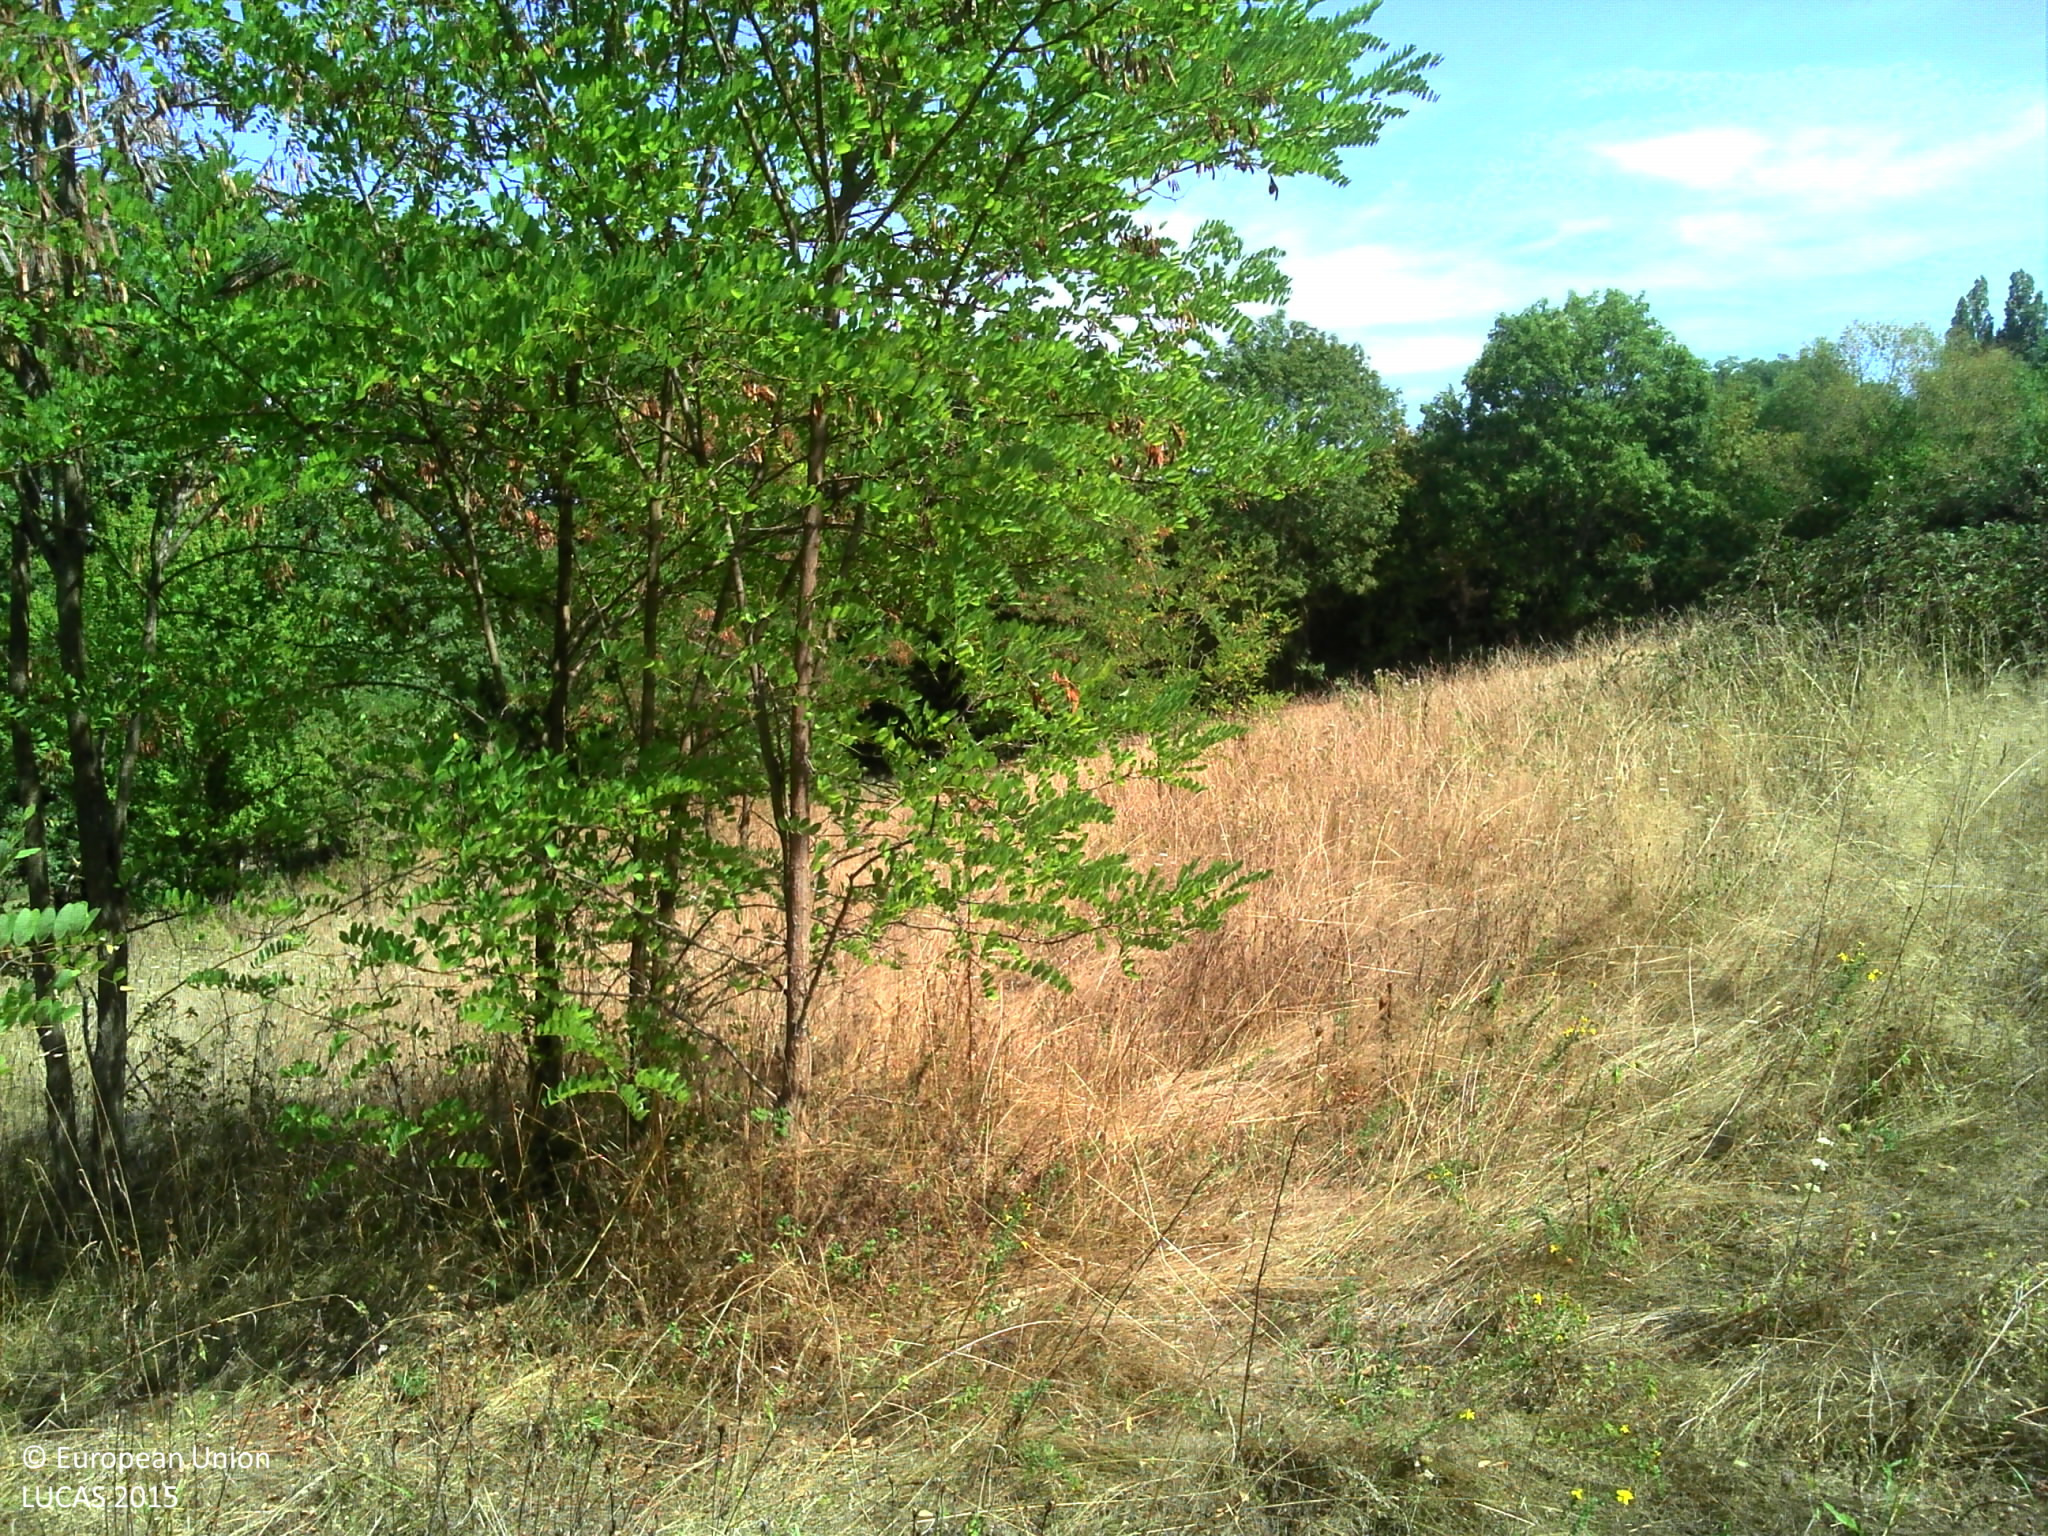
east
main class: Grassland
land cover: Grassland with sparse tree/shrub cover
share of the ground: > 75 %
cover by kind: herbaceous plants 95 %, broadleaved forest trees 5 %
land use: Agriculture (excluding fallow land and kitchen gardens)
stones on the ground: 10 - 25 %
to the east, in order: Grassland with sparse tree/shrub cover; Grassland without tree/shrub cover; Broadleaved woodland; Spontaneously vegetated surfaces; Abandoned hedges; Spontaneously vegetated surfaces; Grassland without tree/shrub cover
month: August
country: FR
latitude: 45.9838
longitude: 4.6715
